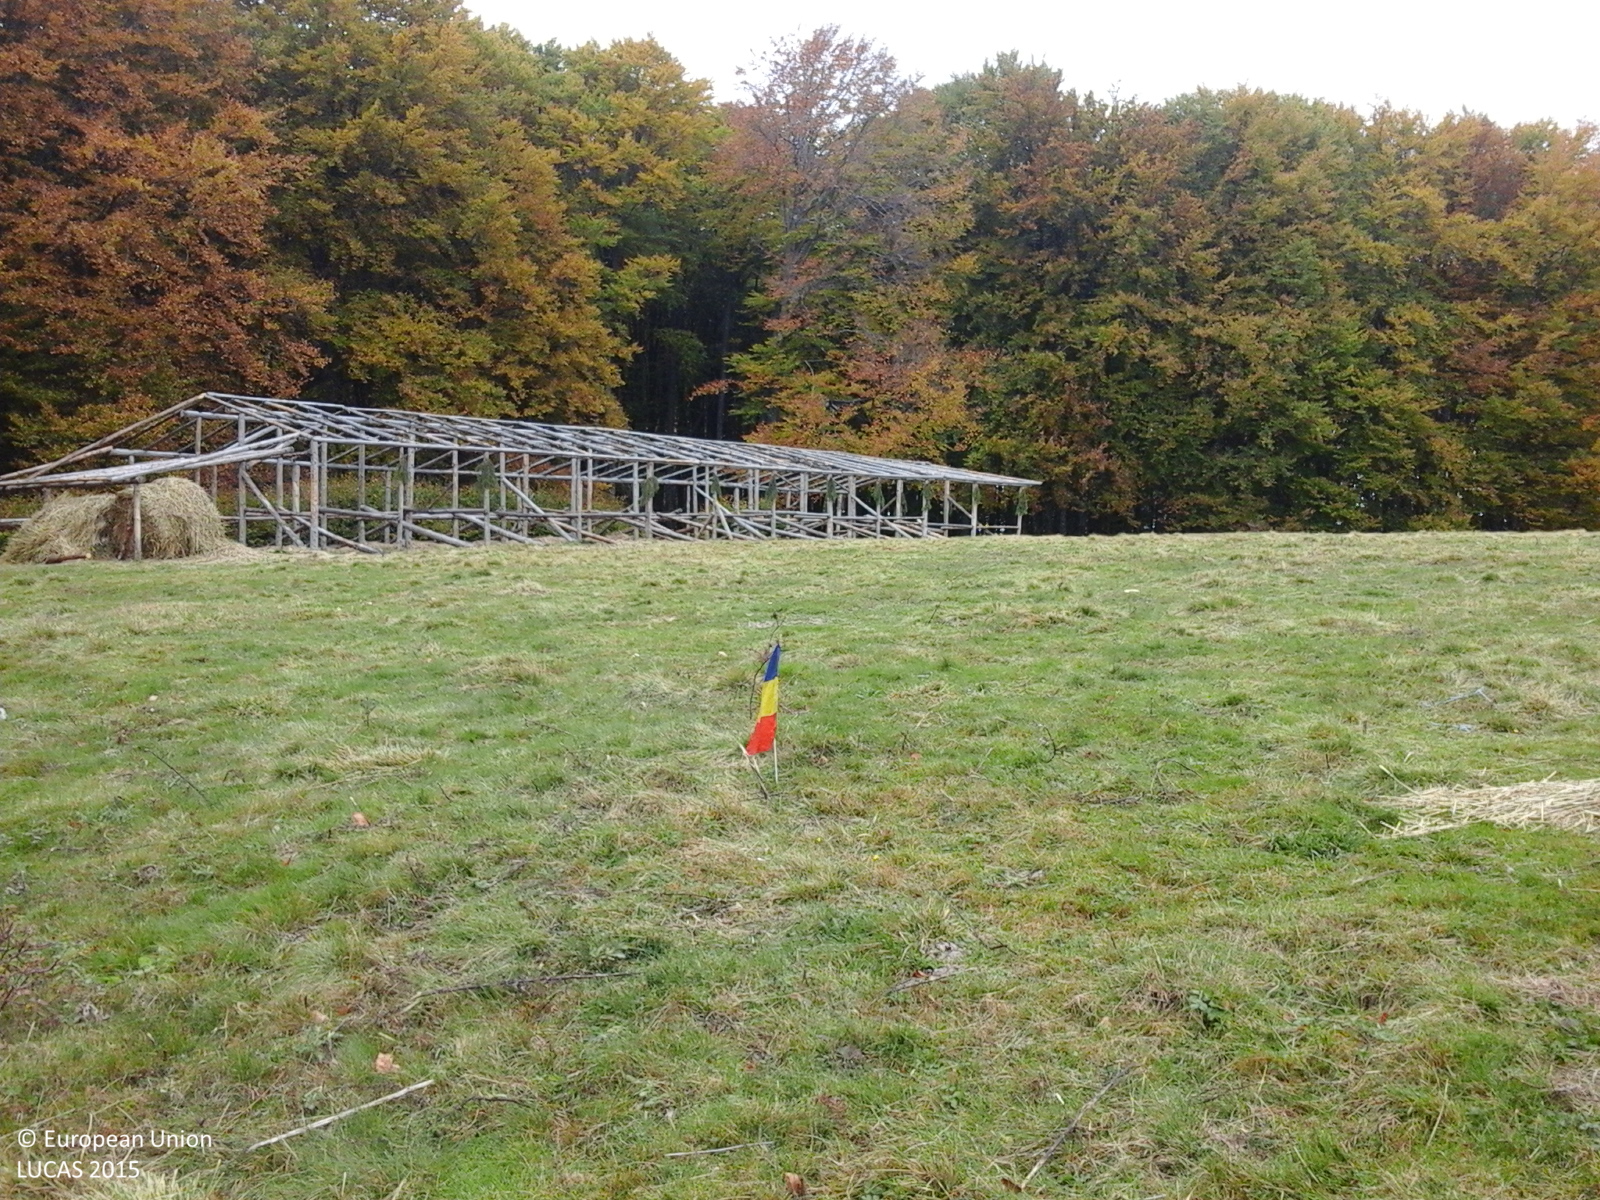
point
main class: Grassland
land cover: Grassland without tree/shrub cover
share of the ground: > 75 %
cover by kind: herbaceous plants 100 %
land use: Agriculture (excluding fallow land and kitchen gardens)
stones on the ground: < 10 %
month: October
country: RO
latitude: 46.6084
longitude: 24.9685
